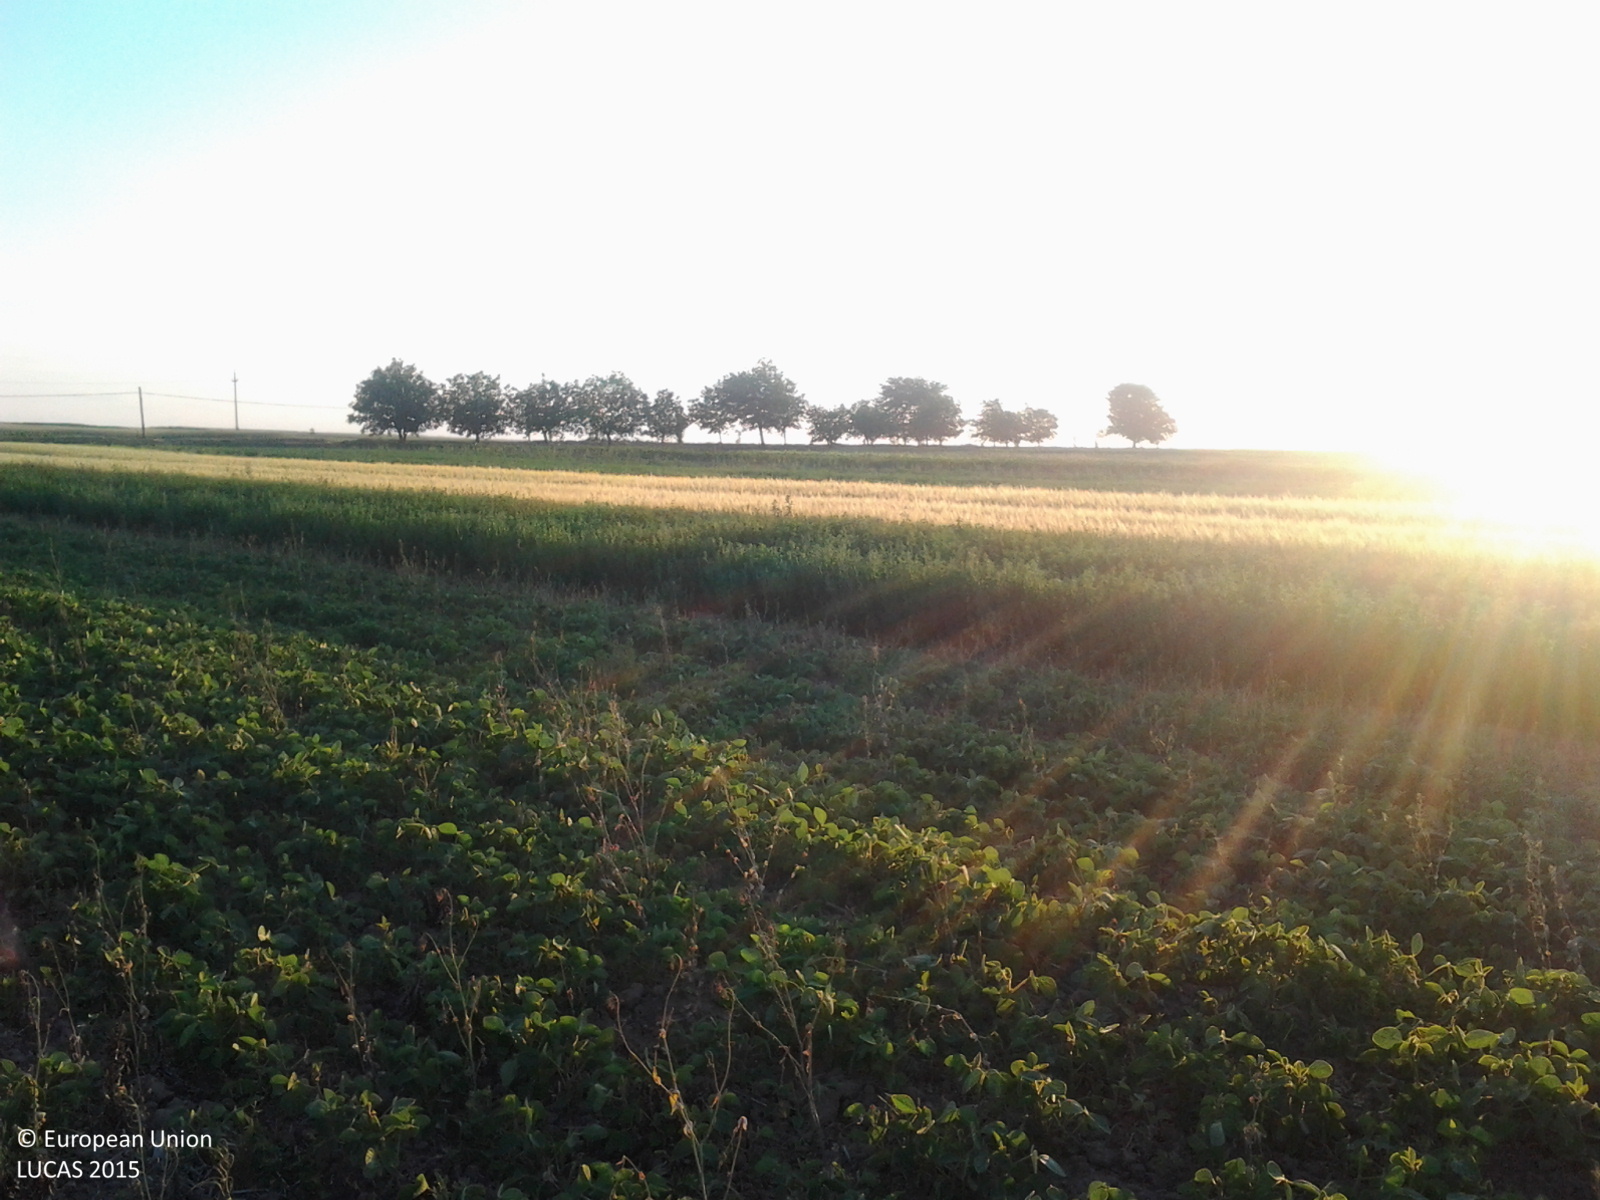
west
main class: Cropland
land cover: Soya
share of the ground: 25 - 50 %
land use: Agriculture (excluding fallow land and kitchen gardens)
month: June
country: RO
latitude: 47.7215
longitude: 26.5011
